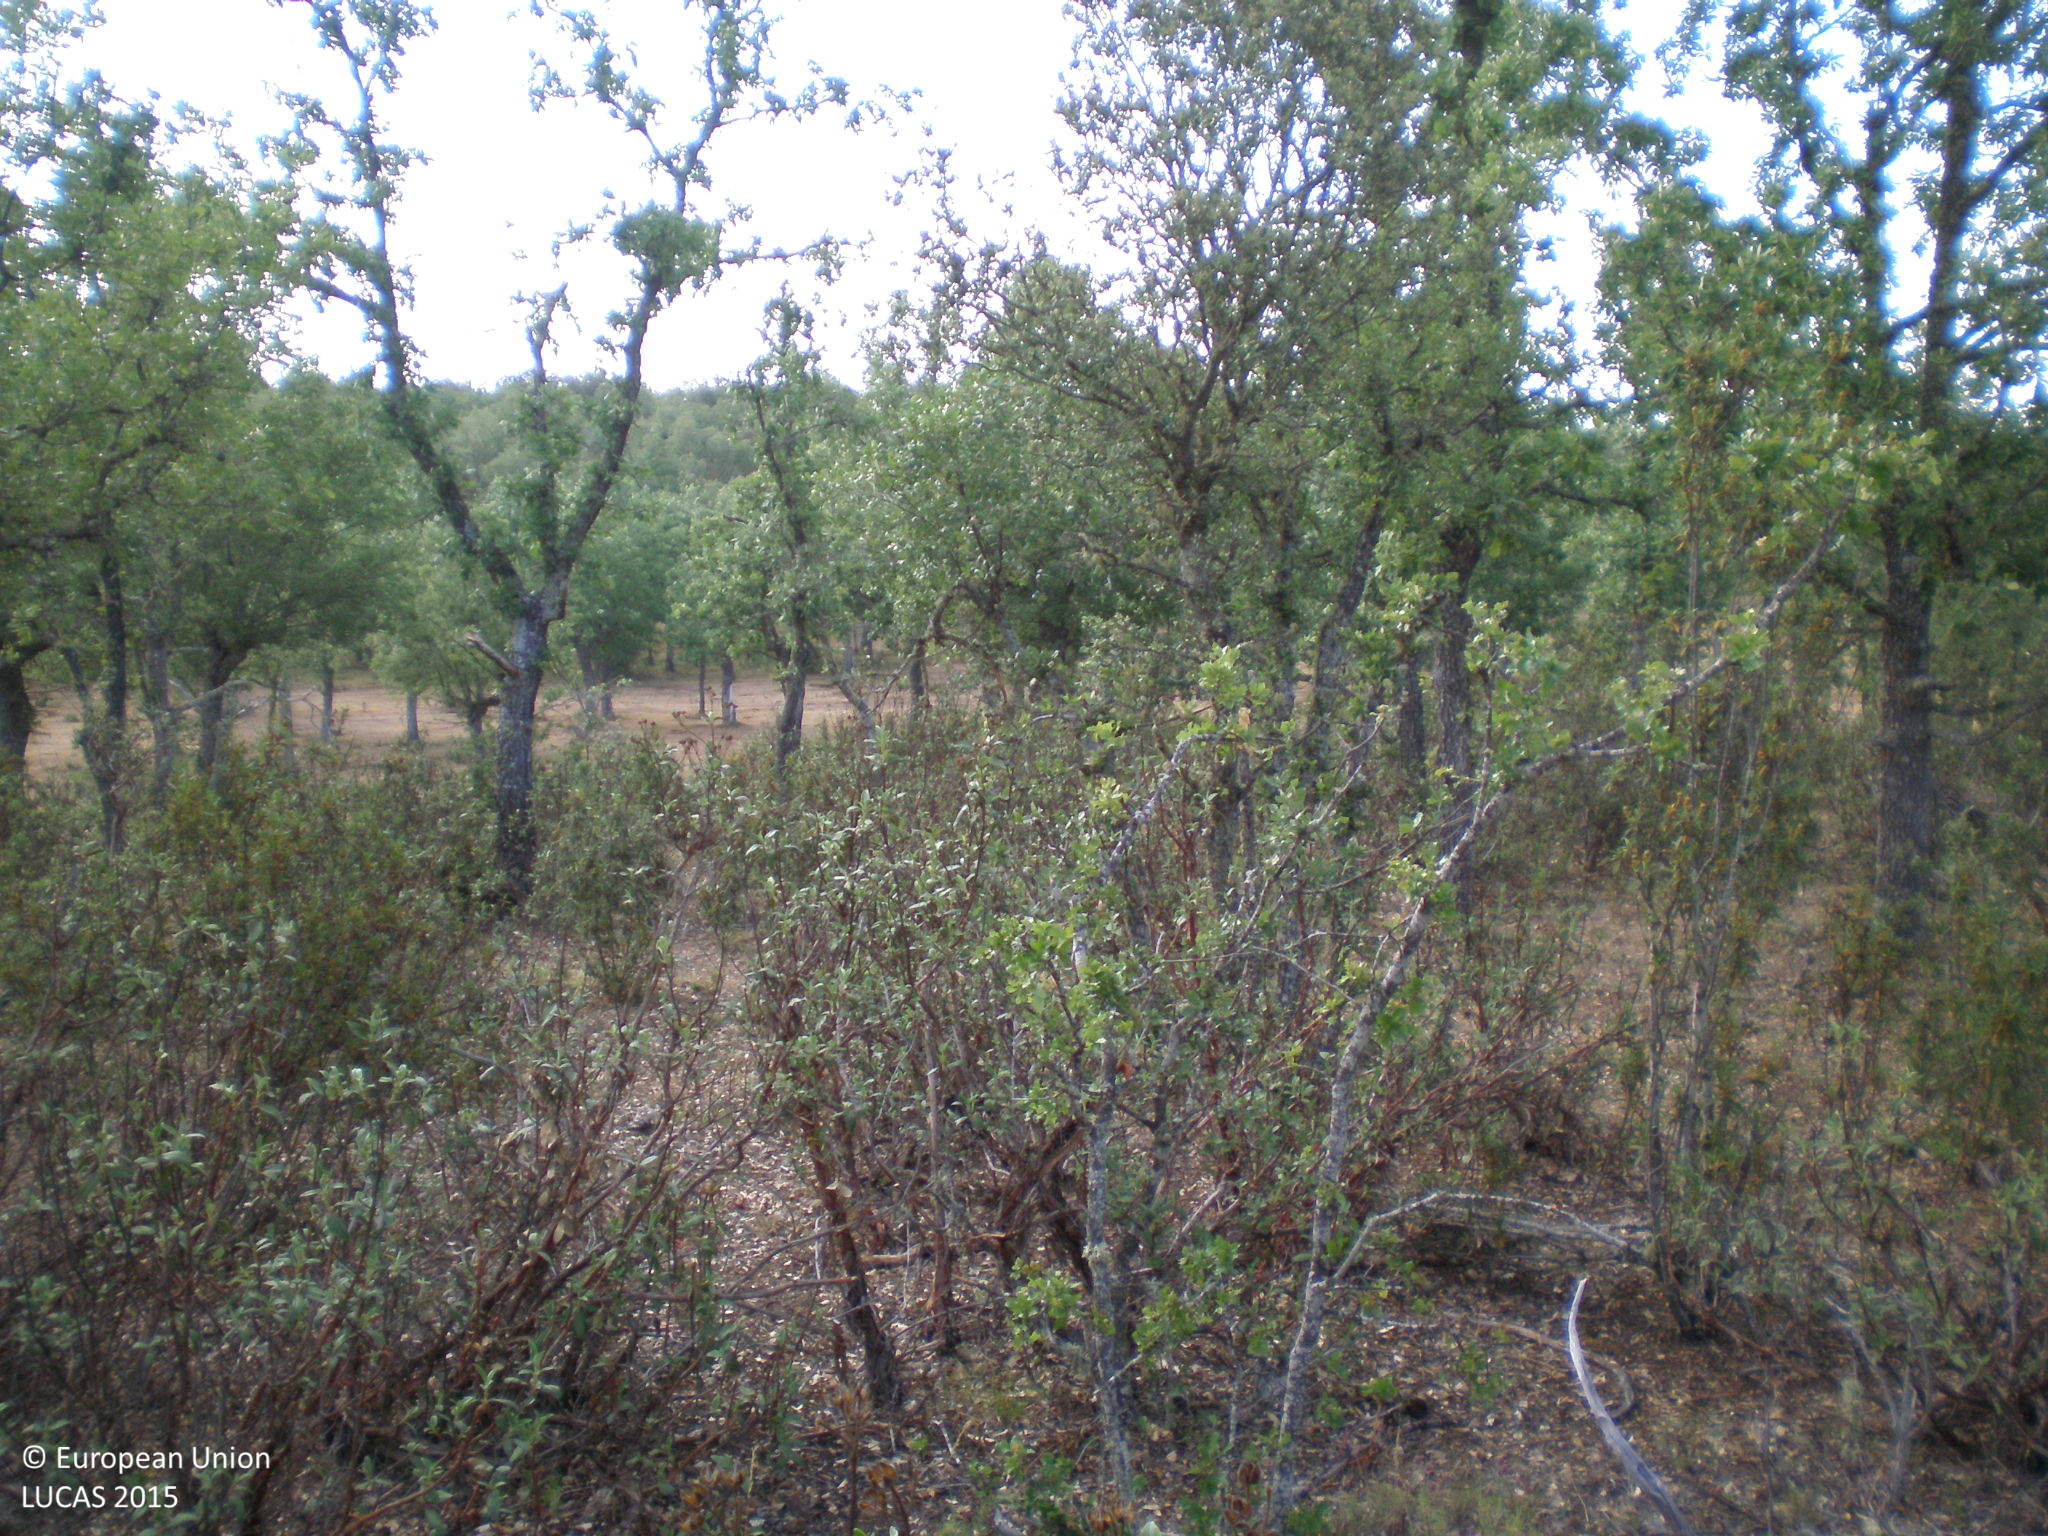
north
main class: Woodland
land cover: Broadleaved woodland
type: broadleaved evergreen forest
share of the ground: > 75 %
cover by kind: broadleaved forest trees 90 %, herbaceous plants 10 %
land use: Forestry
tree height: > 5 m
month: June
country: ES
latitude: 41.2296
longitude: -5.7467
